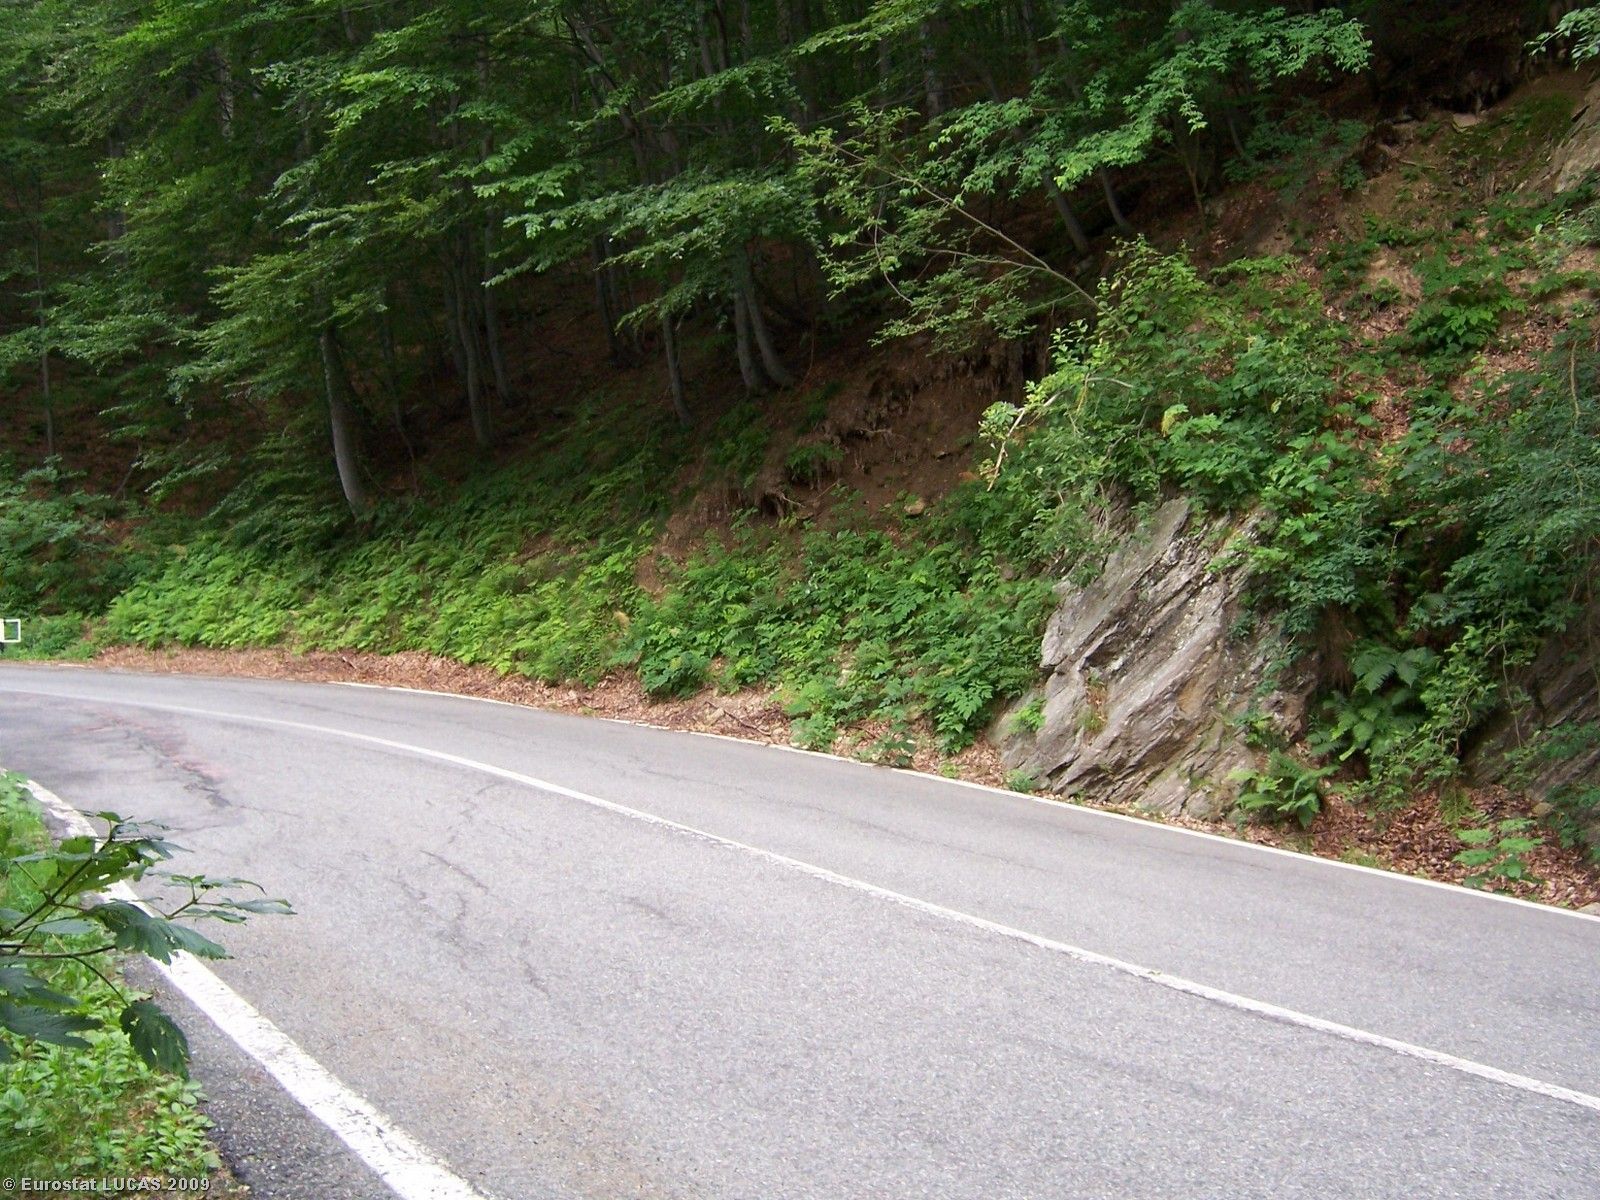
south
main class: Woodland
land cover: Broadleaved woodland
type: mountainous beech forest
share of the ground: > 75 %
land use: Unused
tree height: > 5 m
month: July
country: IT
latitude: 45.2012
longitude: 7.3691
